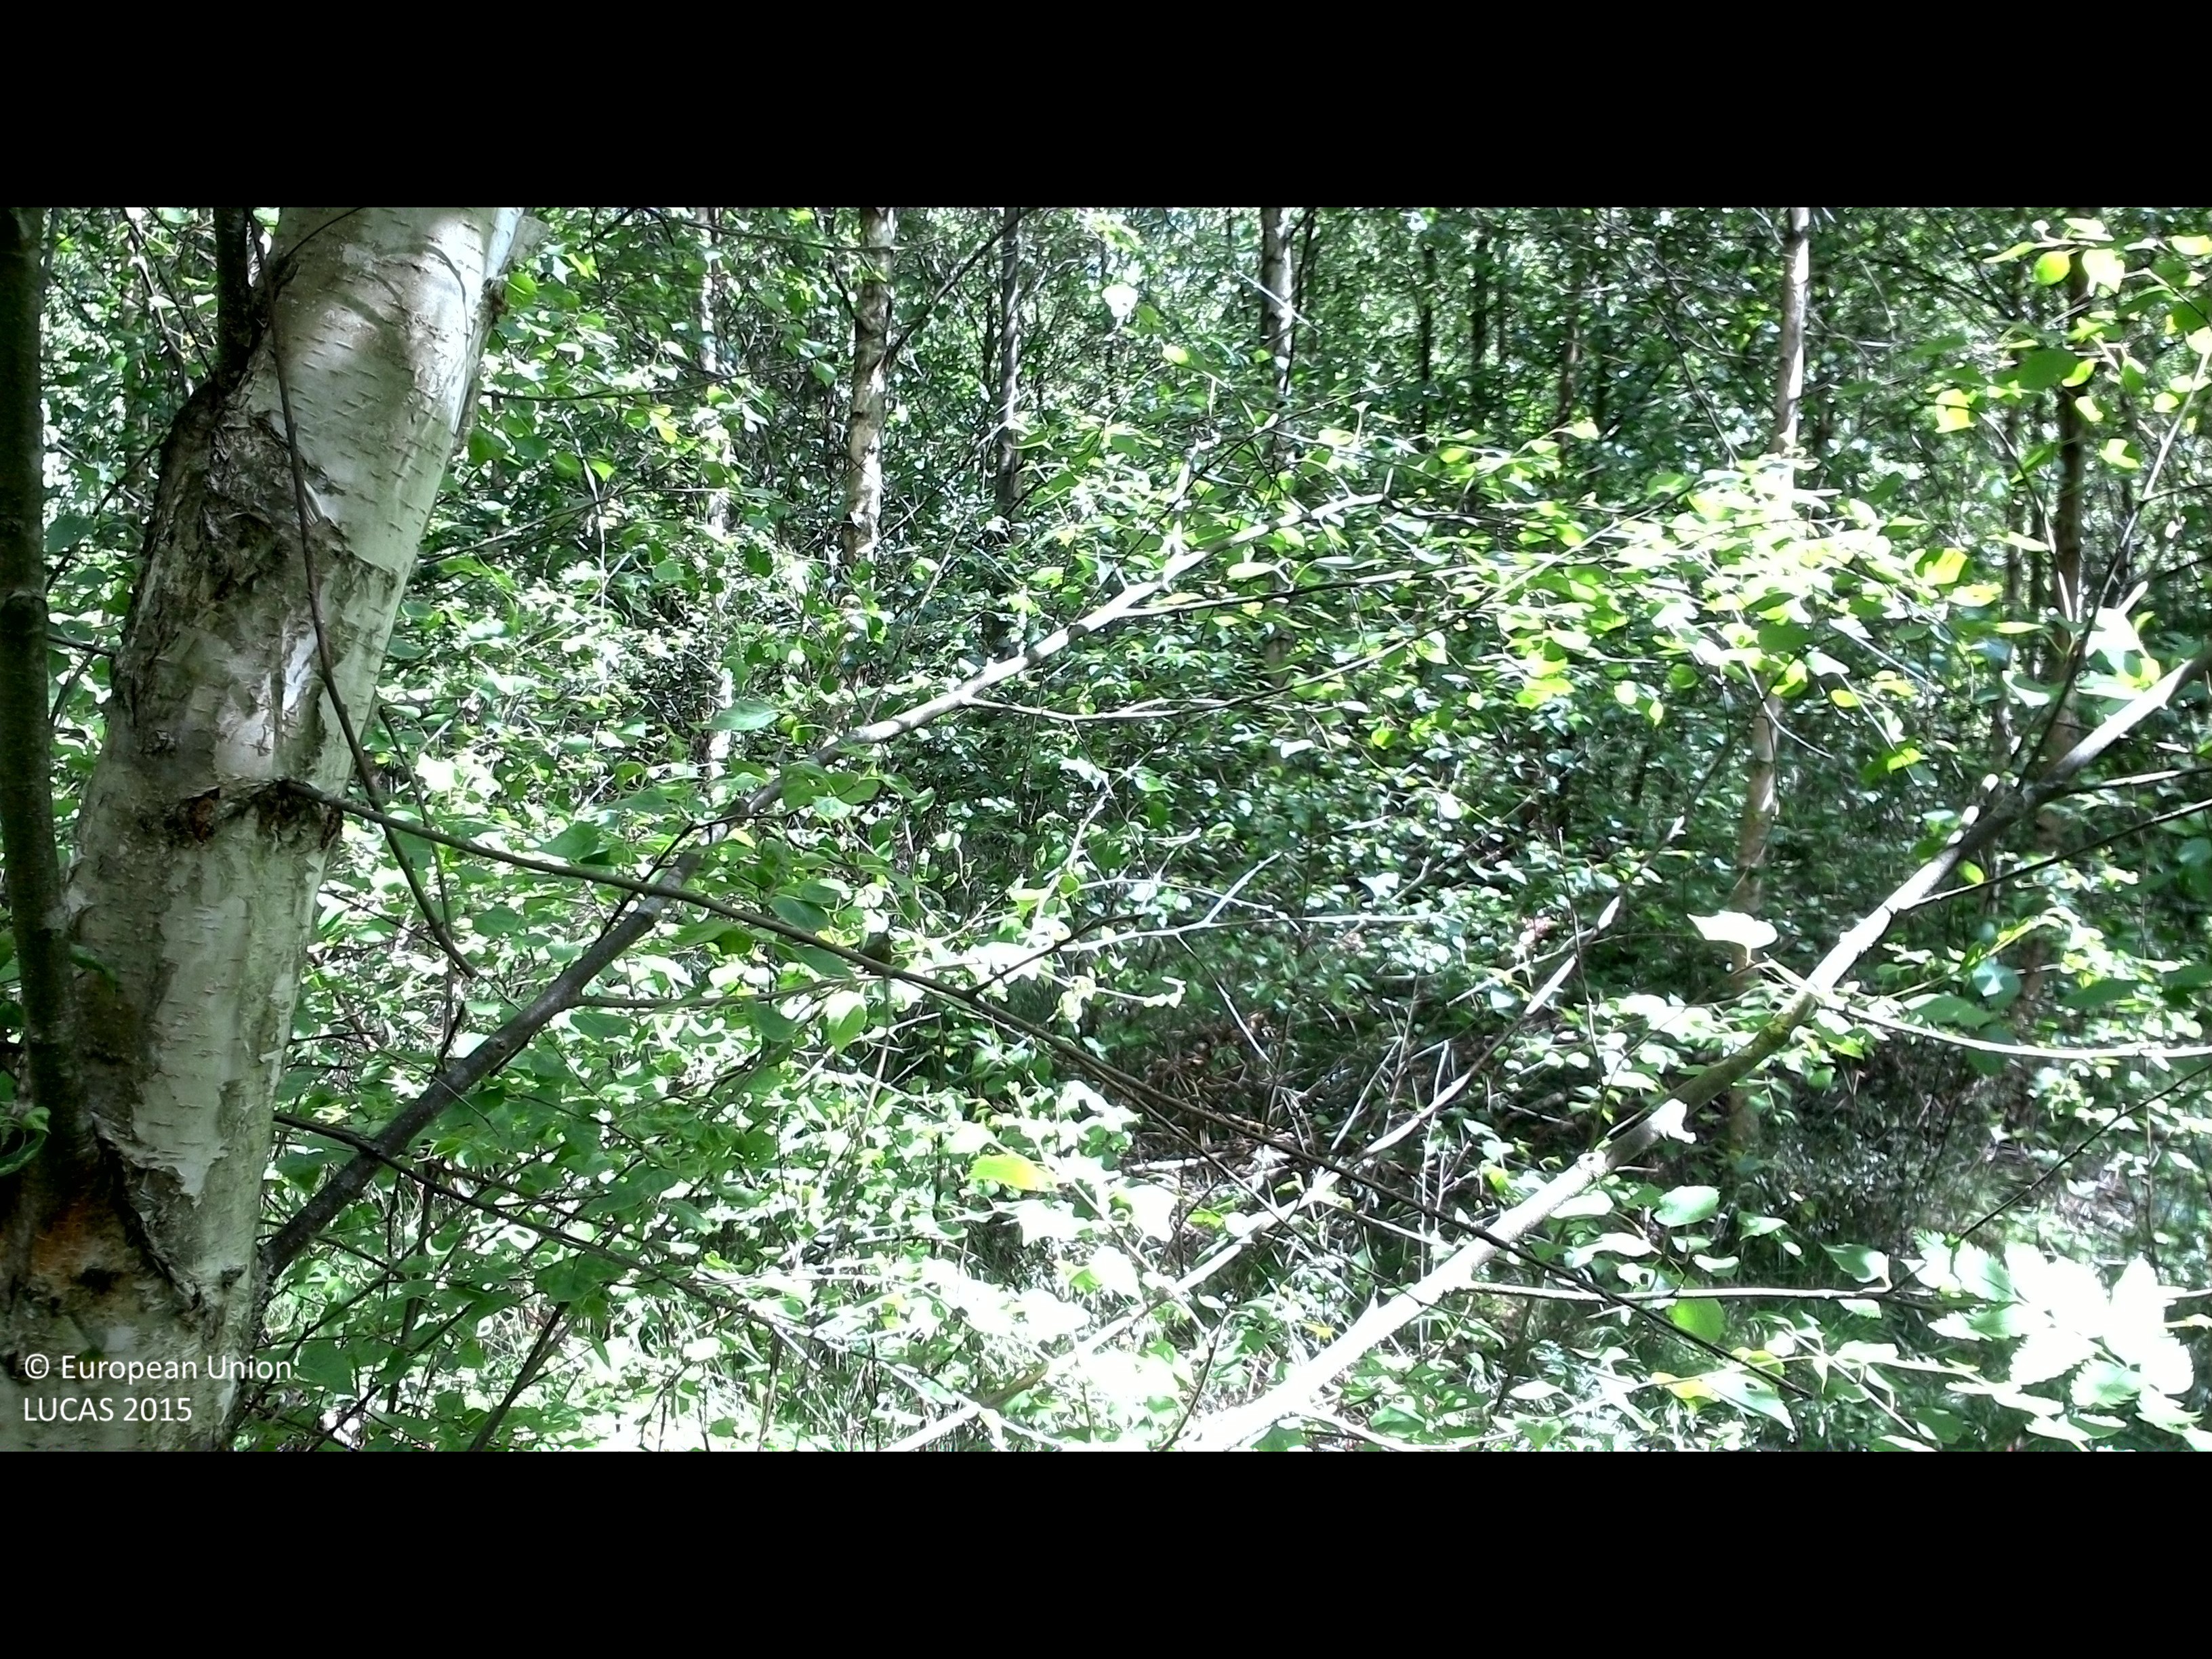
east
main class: Woodland
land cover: Broadleaved woodland
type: boreal forest
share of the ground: > 75 %
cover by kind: broadleaved forest trees 75 %, shrubs 10 %, herbaceous plants 10 %, coniferous forest trees 5 %
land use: Forestry
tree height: < 5 m
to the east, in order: Broadleaved woodland; Ditches and canals; Broadleaved woodland; Tracks; Broadleaved woodland; Paved roads, cycling and walking lanes; Abandoned hedges; Artificial constructions in urban areas; Sand
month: June
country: SE
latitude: 56.3329
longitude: 16.0661
